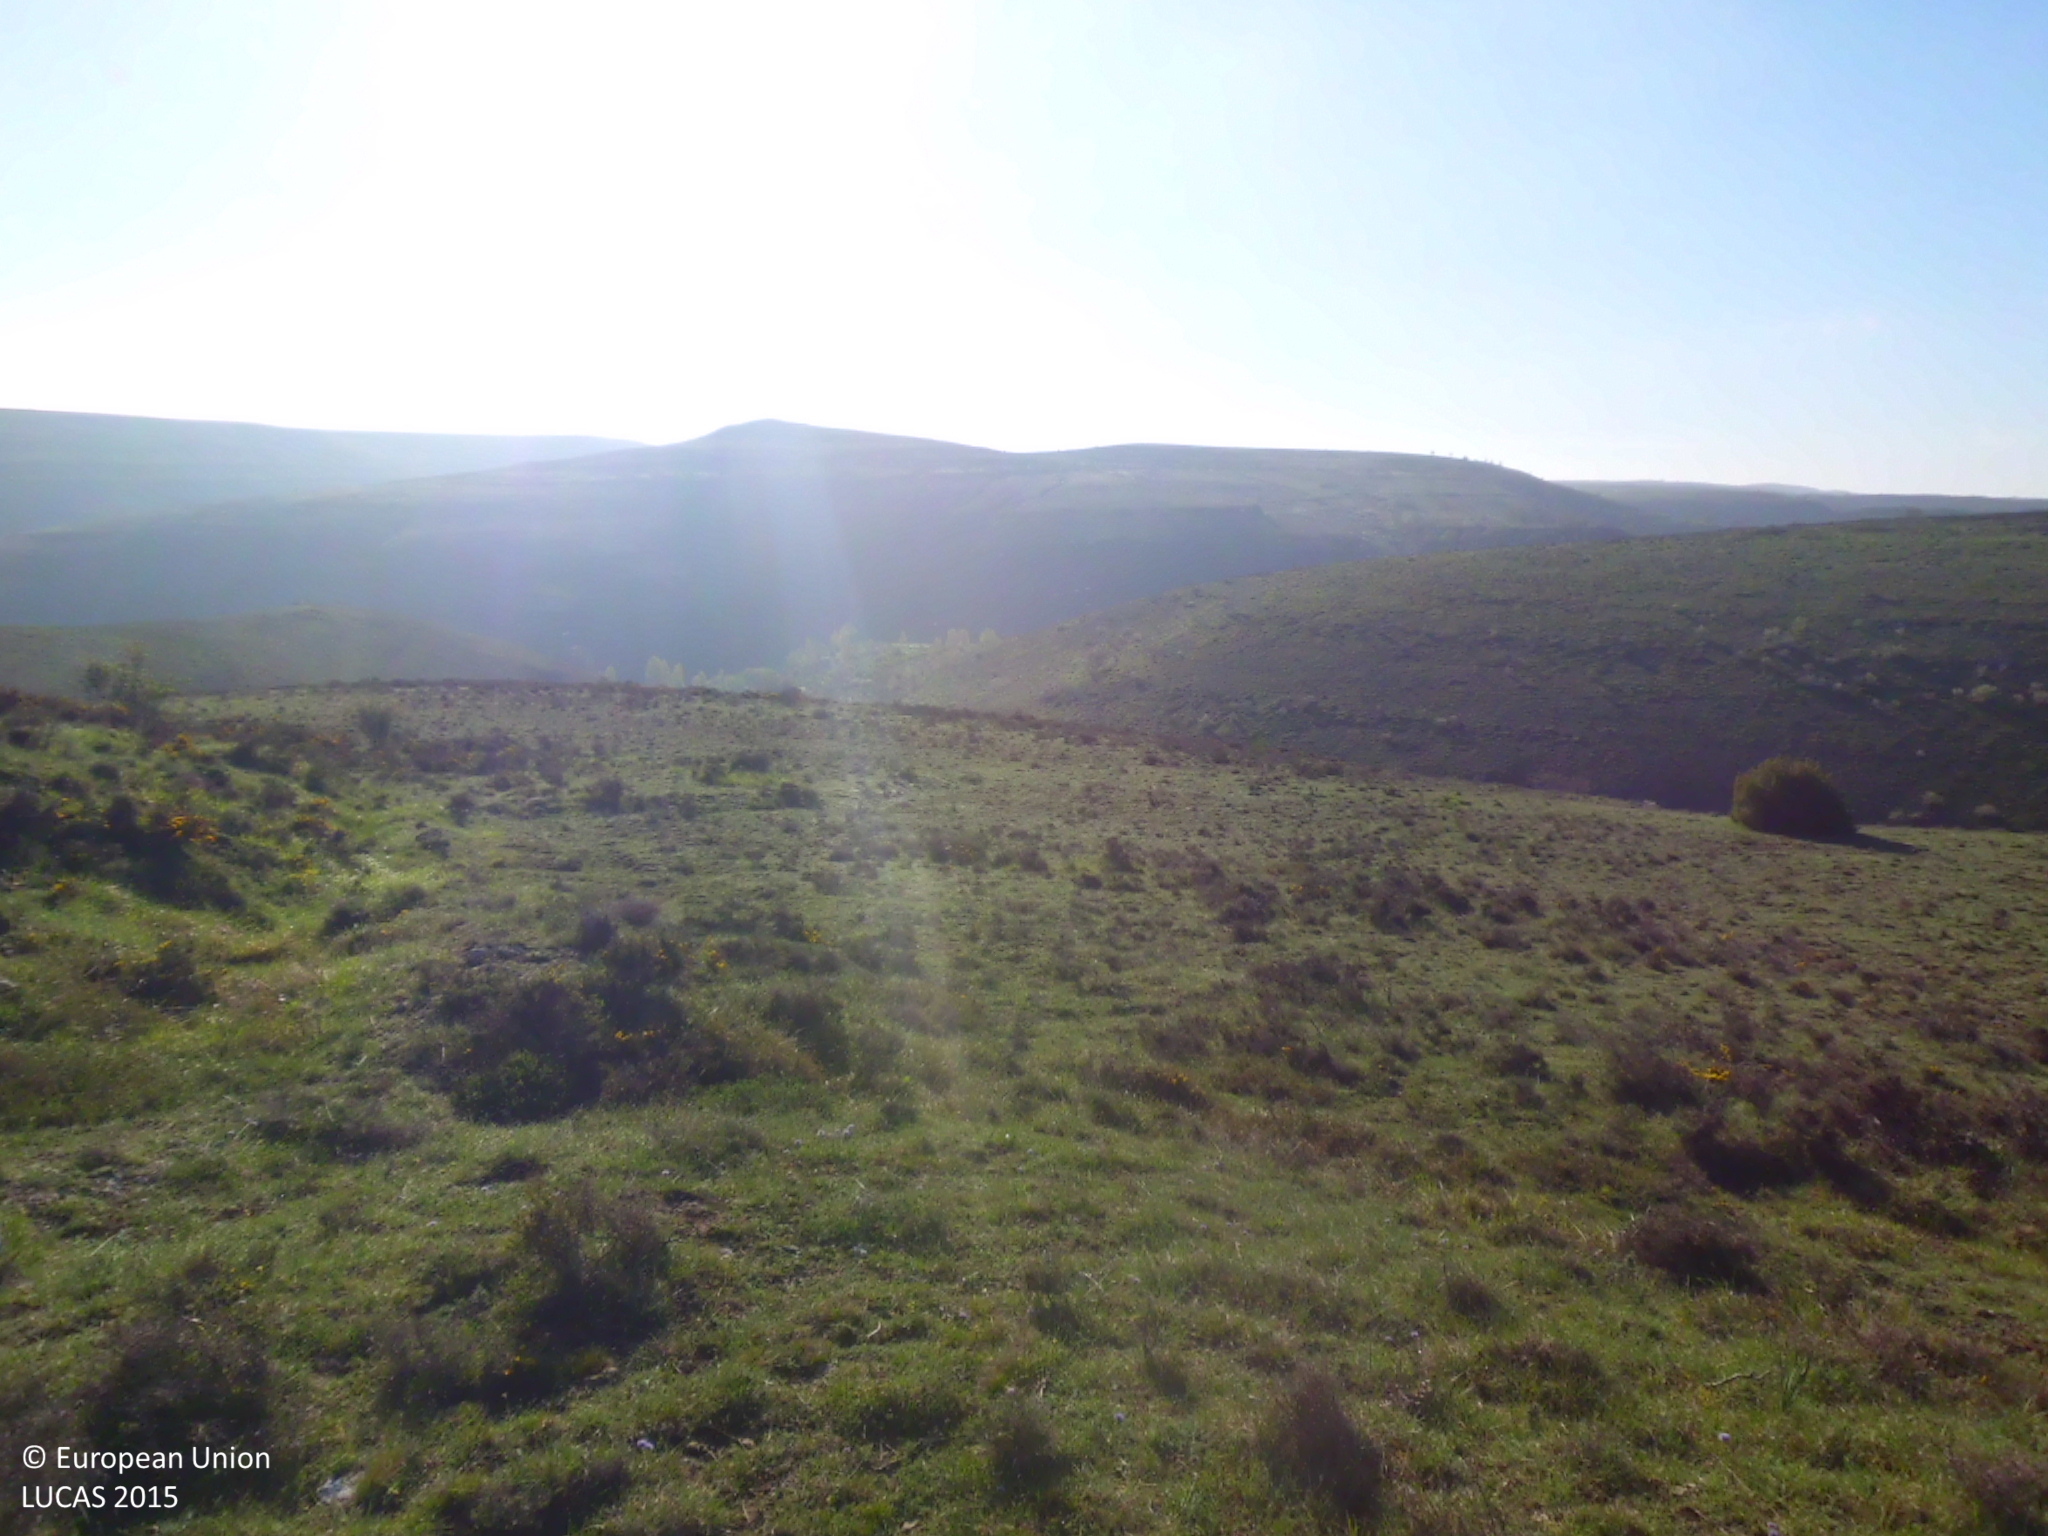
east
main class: Shrubland
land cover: Shrubland without tree cover
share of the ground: 50 - 75 %
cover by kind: shrubs 60 %, herbaceous plants 40 %
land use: Abandoned areas
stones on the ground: 25 - 50 %
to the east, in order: Shrubland without tree cover
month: May
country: ES
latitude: 42.6813
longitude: -3.7454
